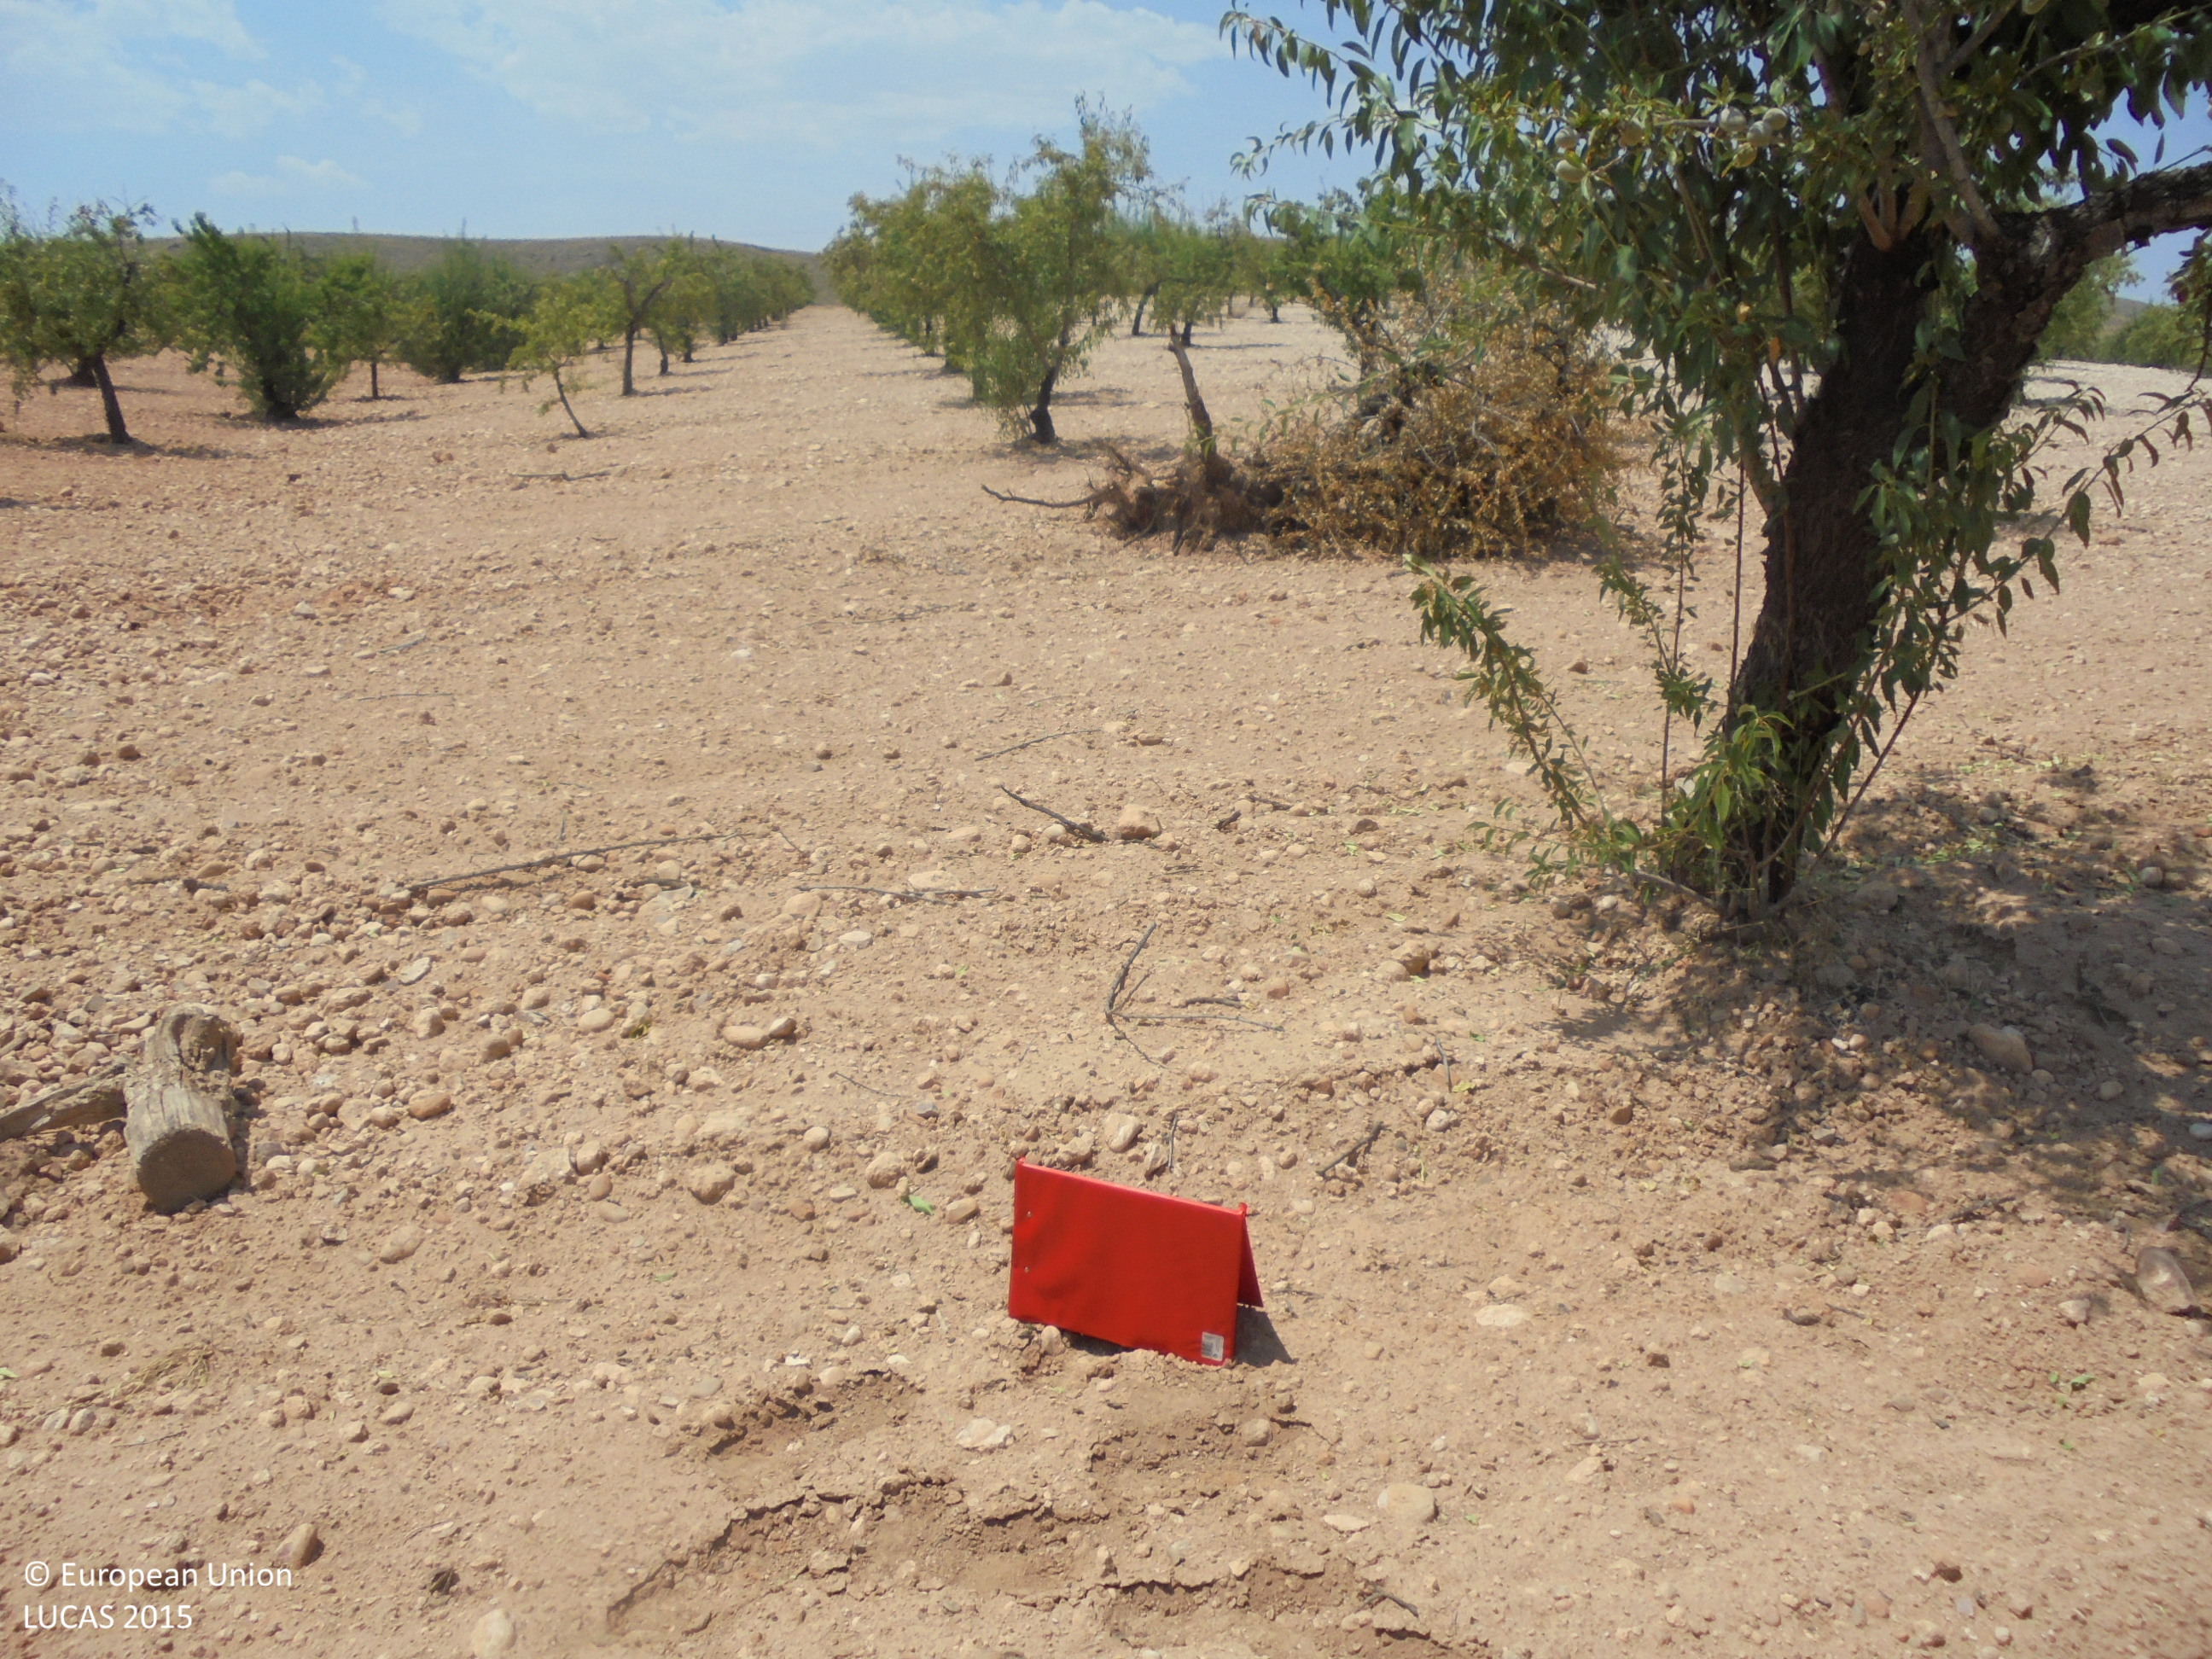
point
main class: Cropland
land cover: Nuts trees
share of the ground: 25 - 50 %
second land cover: Other bare soil
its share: > 75 %
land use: Agriculture (excluding fallow land and kitchen gardens)
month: July
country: ES
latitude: 38.5611
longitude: -1.6881
